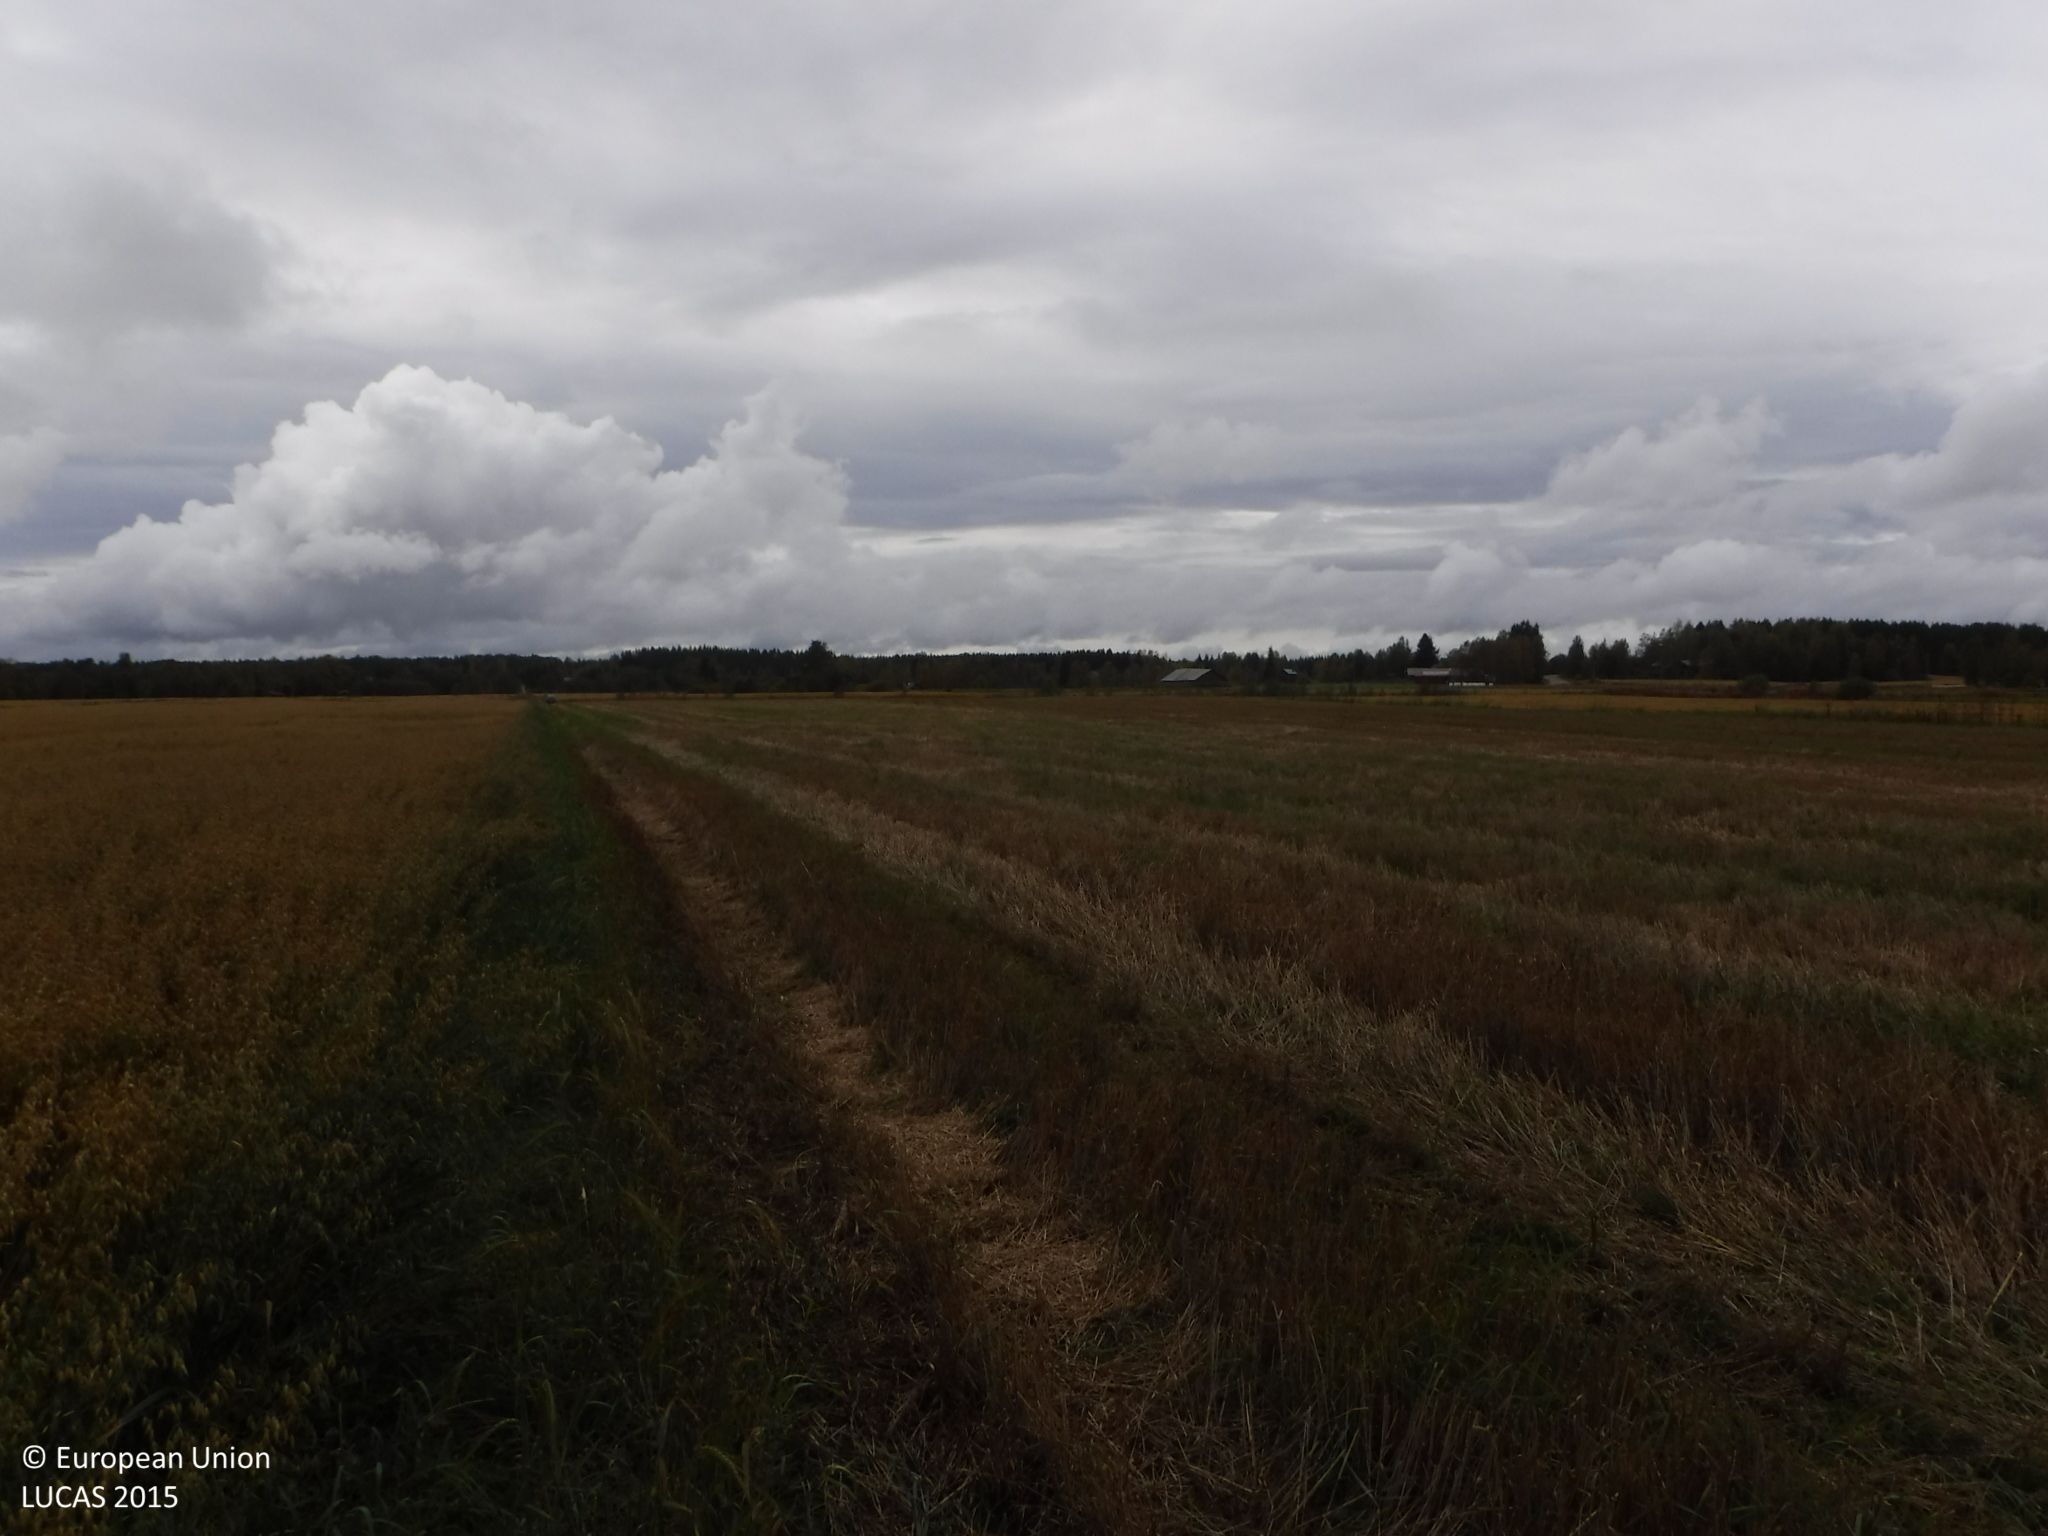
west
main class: Cropland
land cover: Oats
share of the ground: > 75 %
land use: Agriculture (excluding fallow land and kitchen gardens)
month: September
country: FI
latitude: 62.0528
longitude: 22.2783
